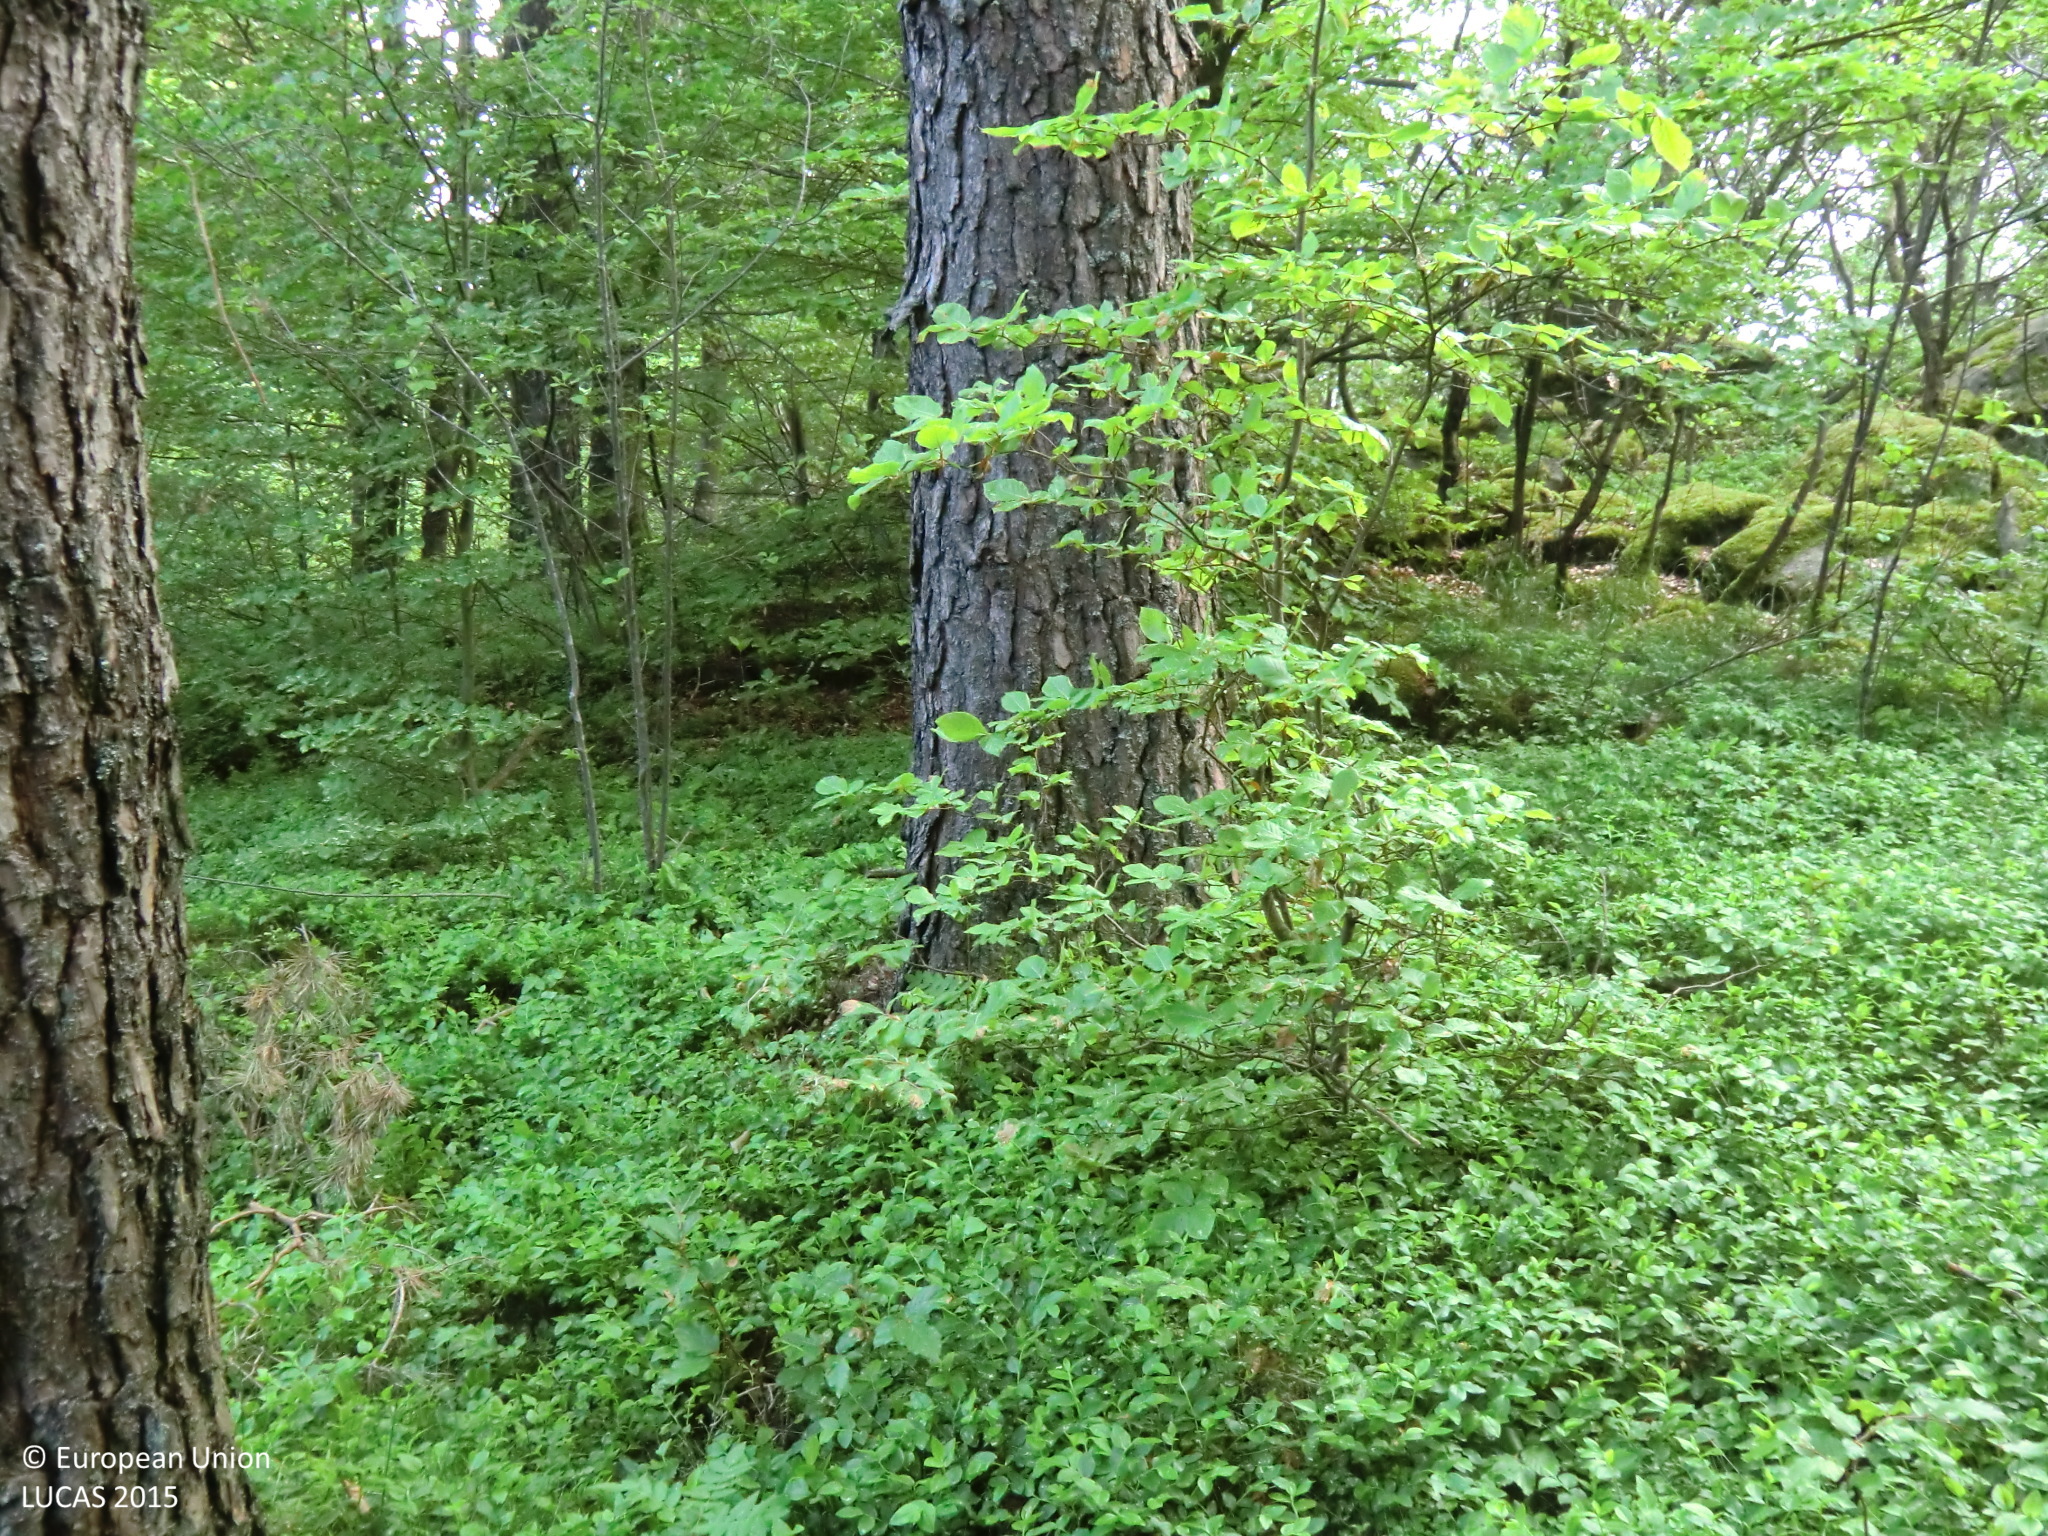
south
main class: Woodland
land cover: Other mixed woodland
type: hemiboreal forest and nemoral coniferous forest and mixed broadleaved-coniferous forest
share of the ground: 50 - 75 %
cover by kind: coniferous forest trees 30 %, broadleaved forest trees 30 %, shrubs 20 %, herbaceous plants 20 %
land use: Forestry
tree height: > 5 m
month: May
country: AT
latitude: 48.3927
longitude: 14.2814
